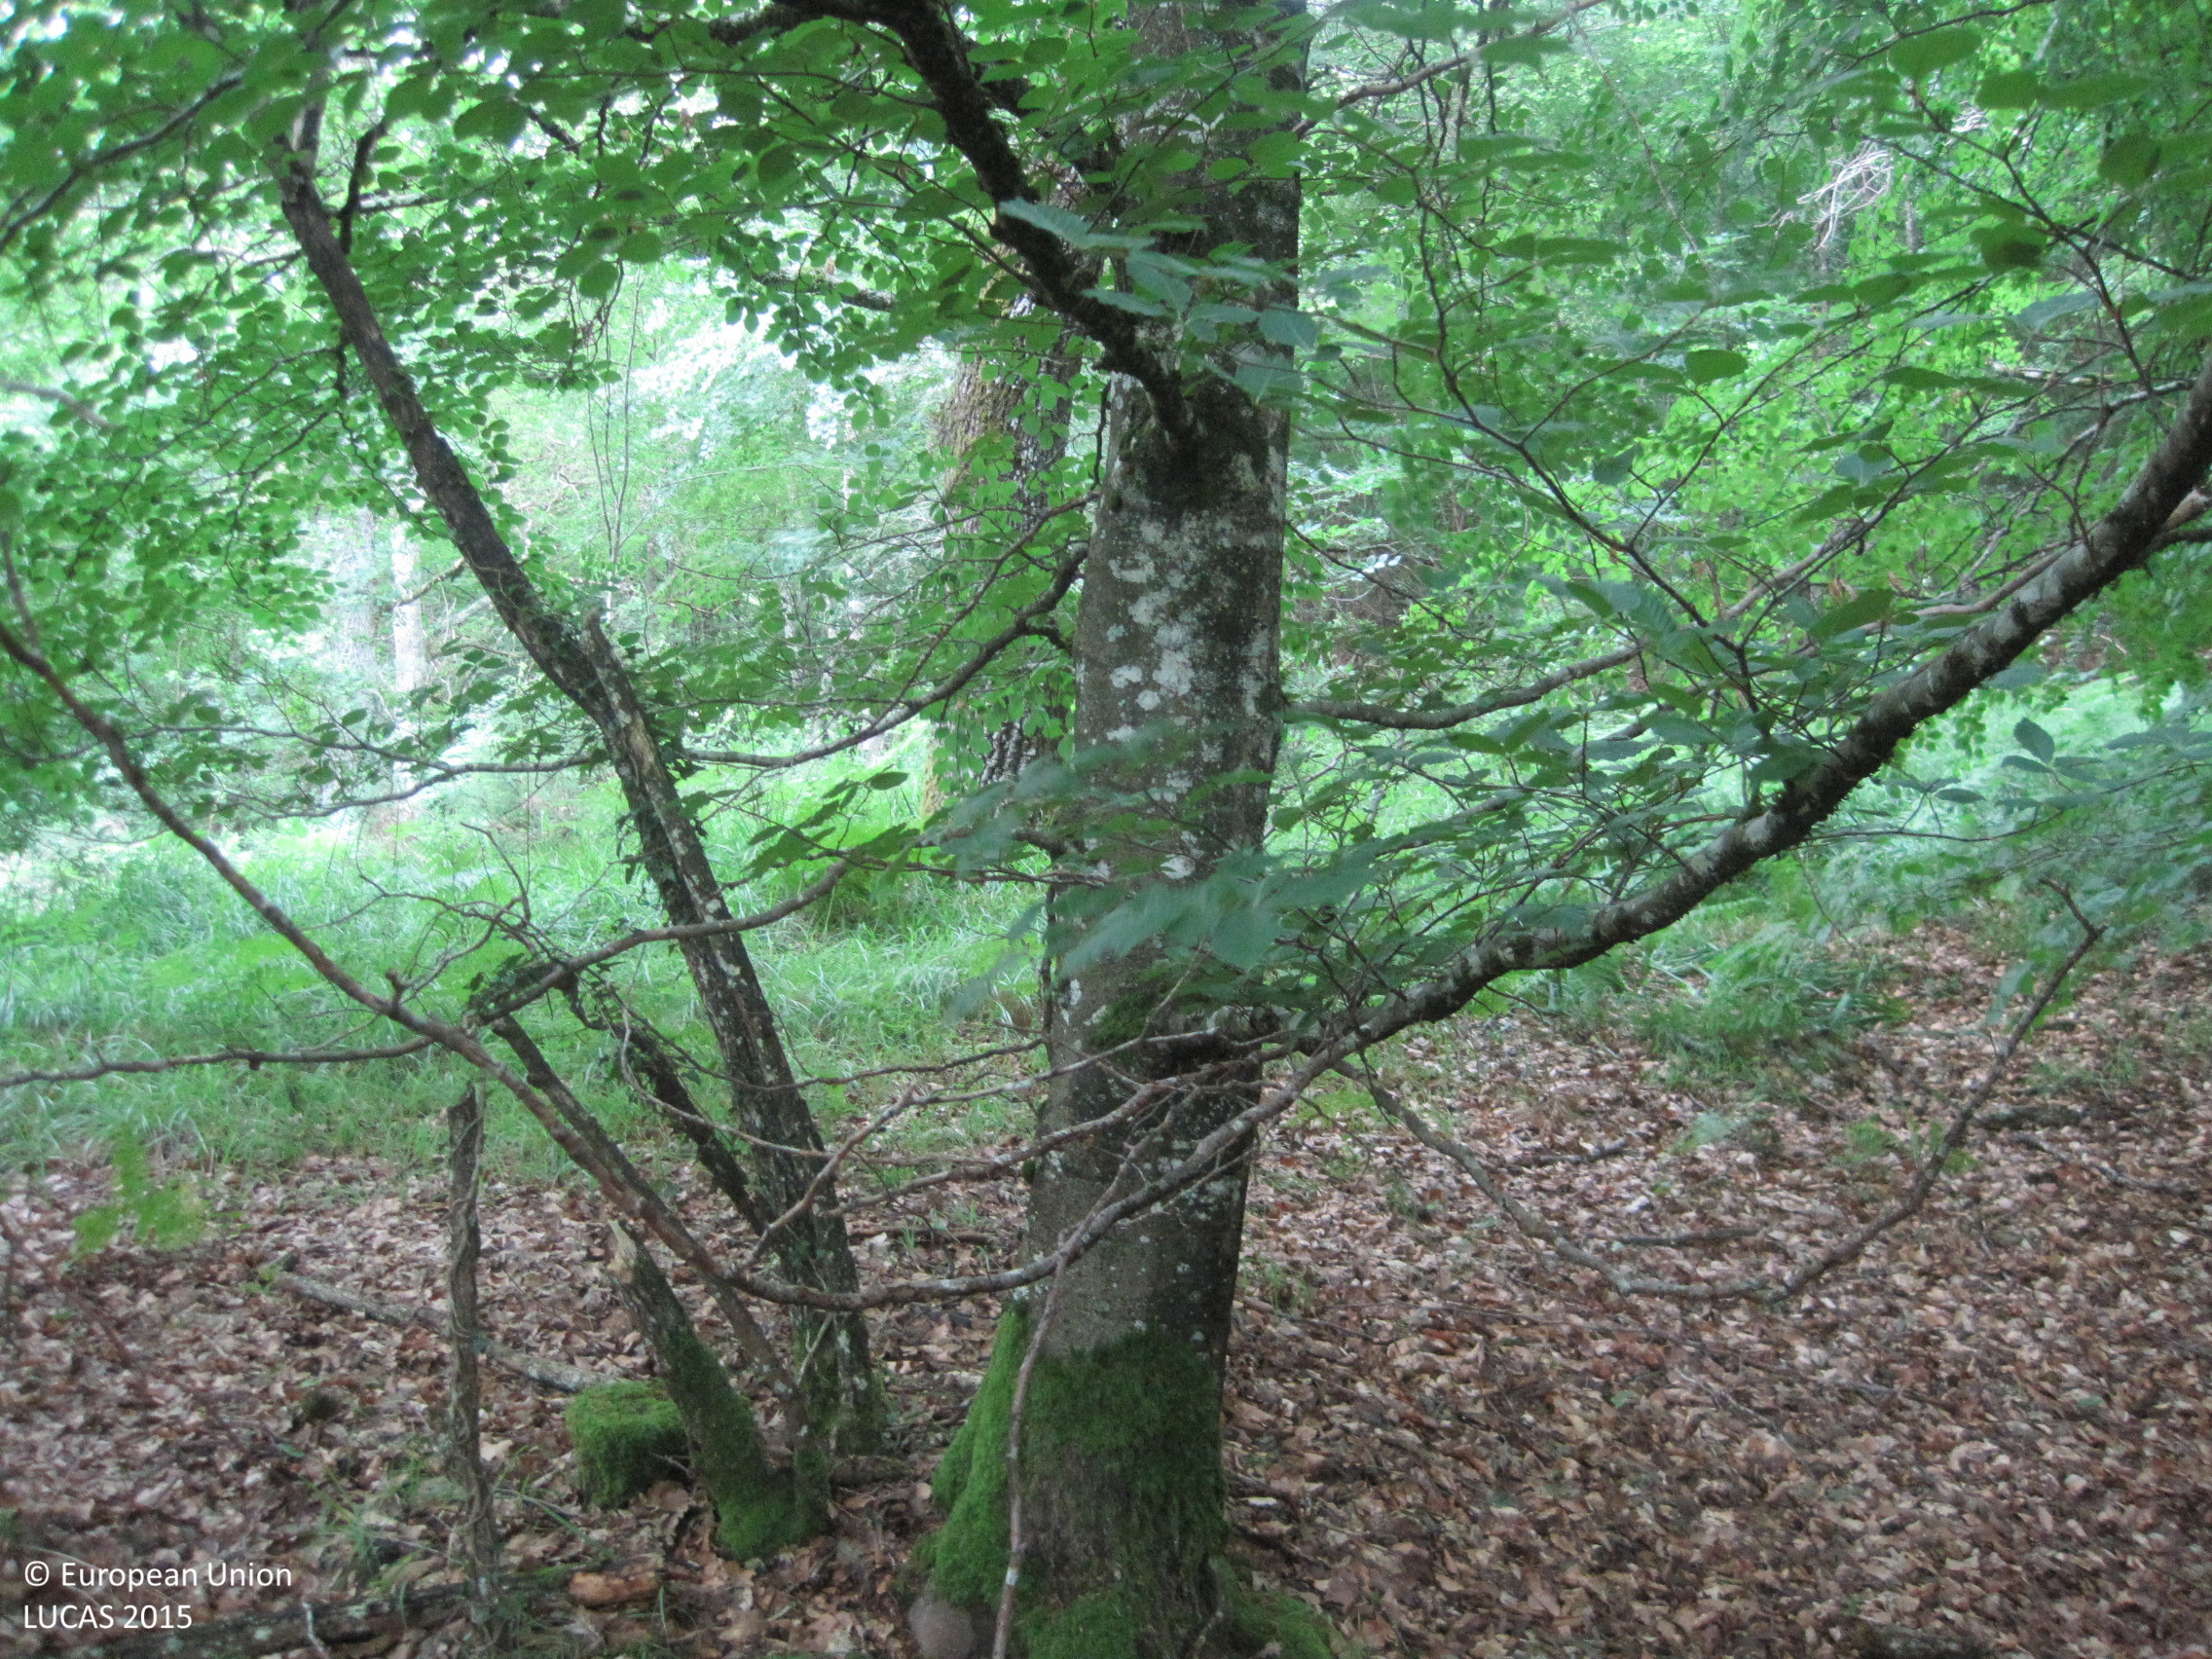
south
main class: Woodland
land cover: Broadleaved woodland
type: beech forest
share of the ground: > 75 %
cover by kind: broadleaved forest trees 100 %
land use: Forestry
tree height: > 5 m
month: June
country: ES
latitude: 43.0000
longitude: -1.8062
